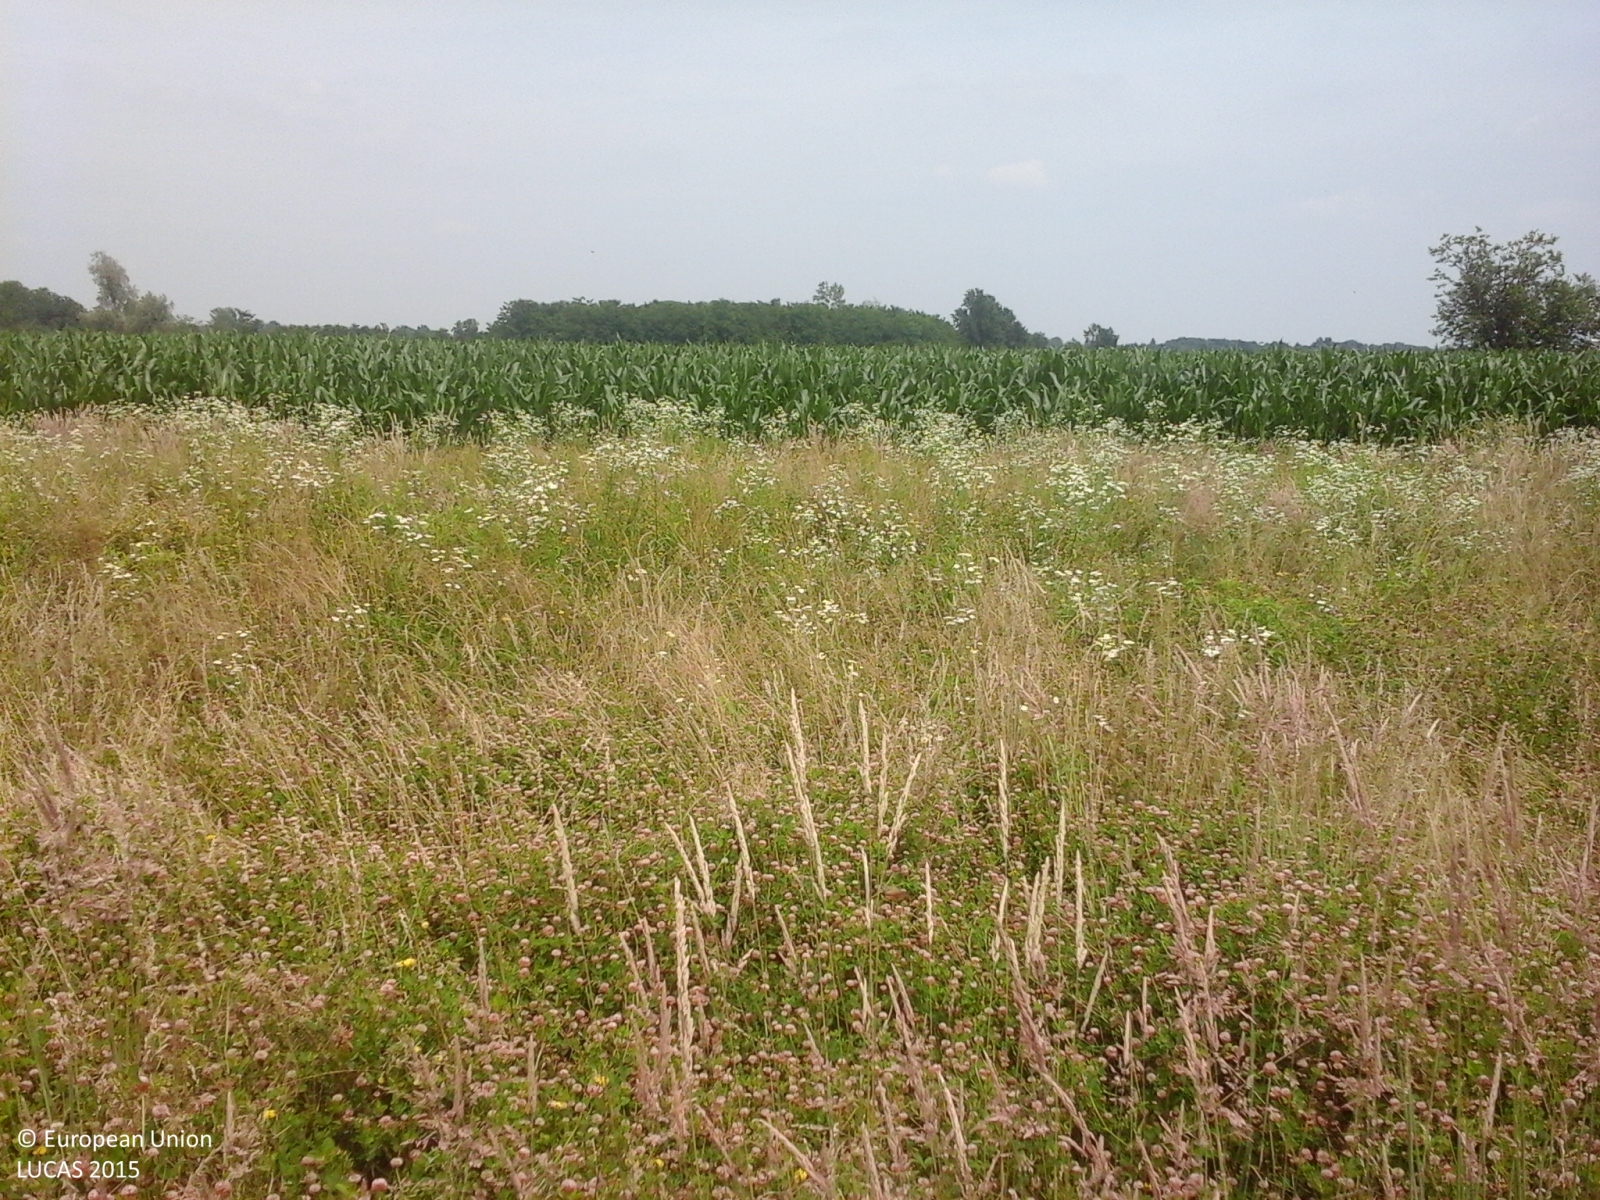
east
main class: Grassland
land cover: Spontaneously vegetated surfaces
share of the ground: > 75 %
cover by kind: herbaceous plants 100 %
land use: Agriculture (excluding fallow land and kitchen gardens)
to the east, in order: Ditches and canals; Spontaneously vegetated surfaces; Maize; Grassland without tree/shrub cover; Maize; Grass margins; Ditches and canals; Grass margins; Tracks; Grass margins; Ditches and canals; Grass margins; Maize
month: June
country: IT
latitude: 45.2831
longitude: 7.7981
